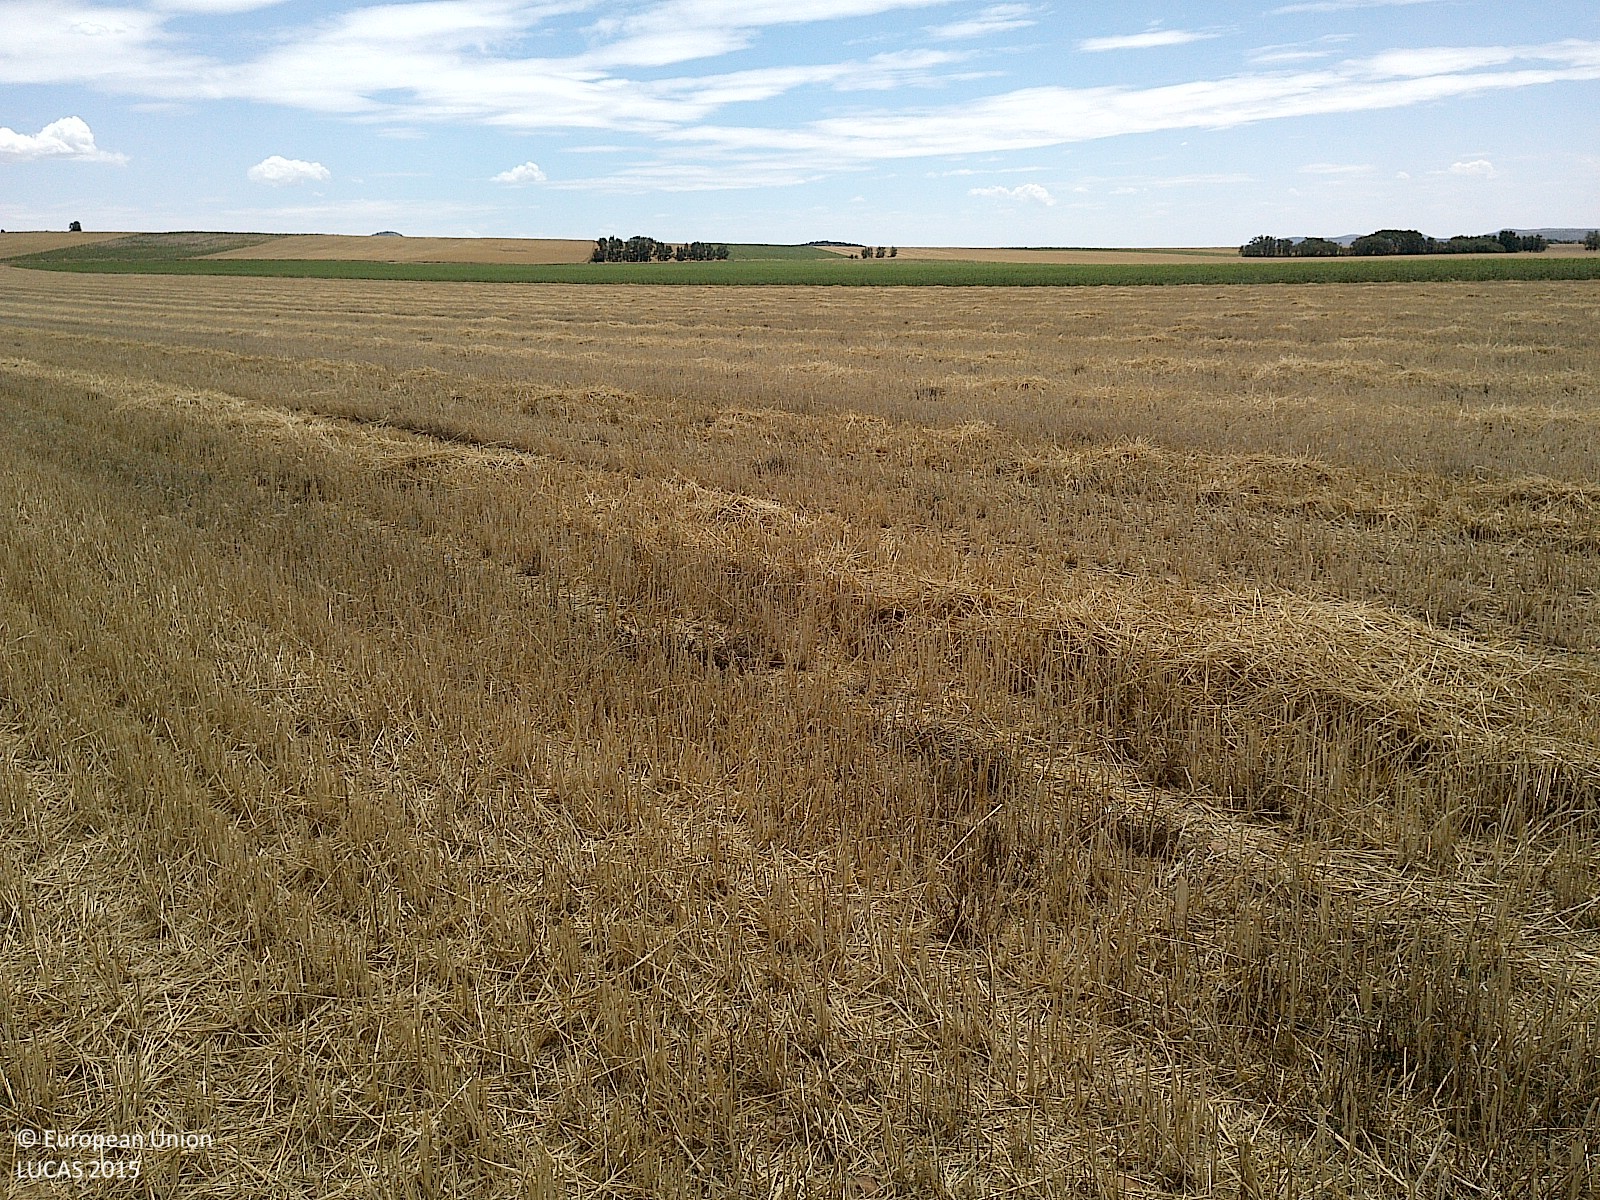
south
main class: Cropland
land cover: Common wheat
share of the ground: < 10 %
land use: Agriculture (excluding fallow land and kitchen gardens)
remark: Harvested field
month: July
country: ES
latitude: 41.6607
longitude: -2.0293
